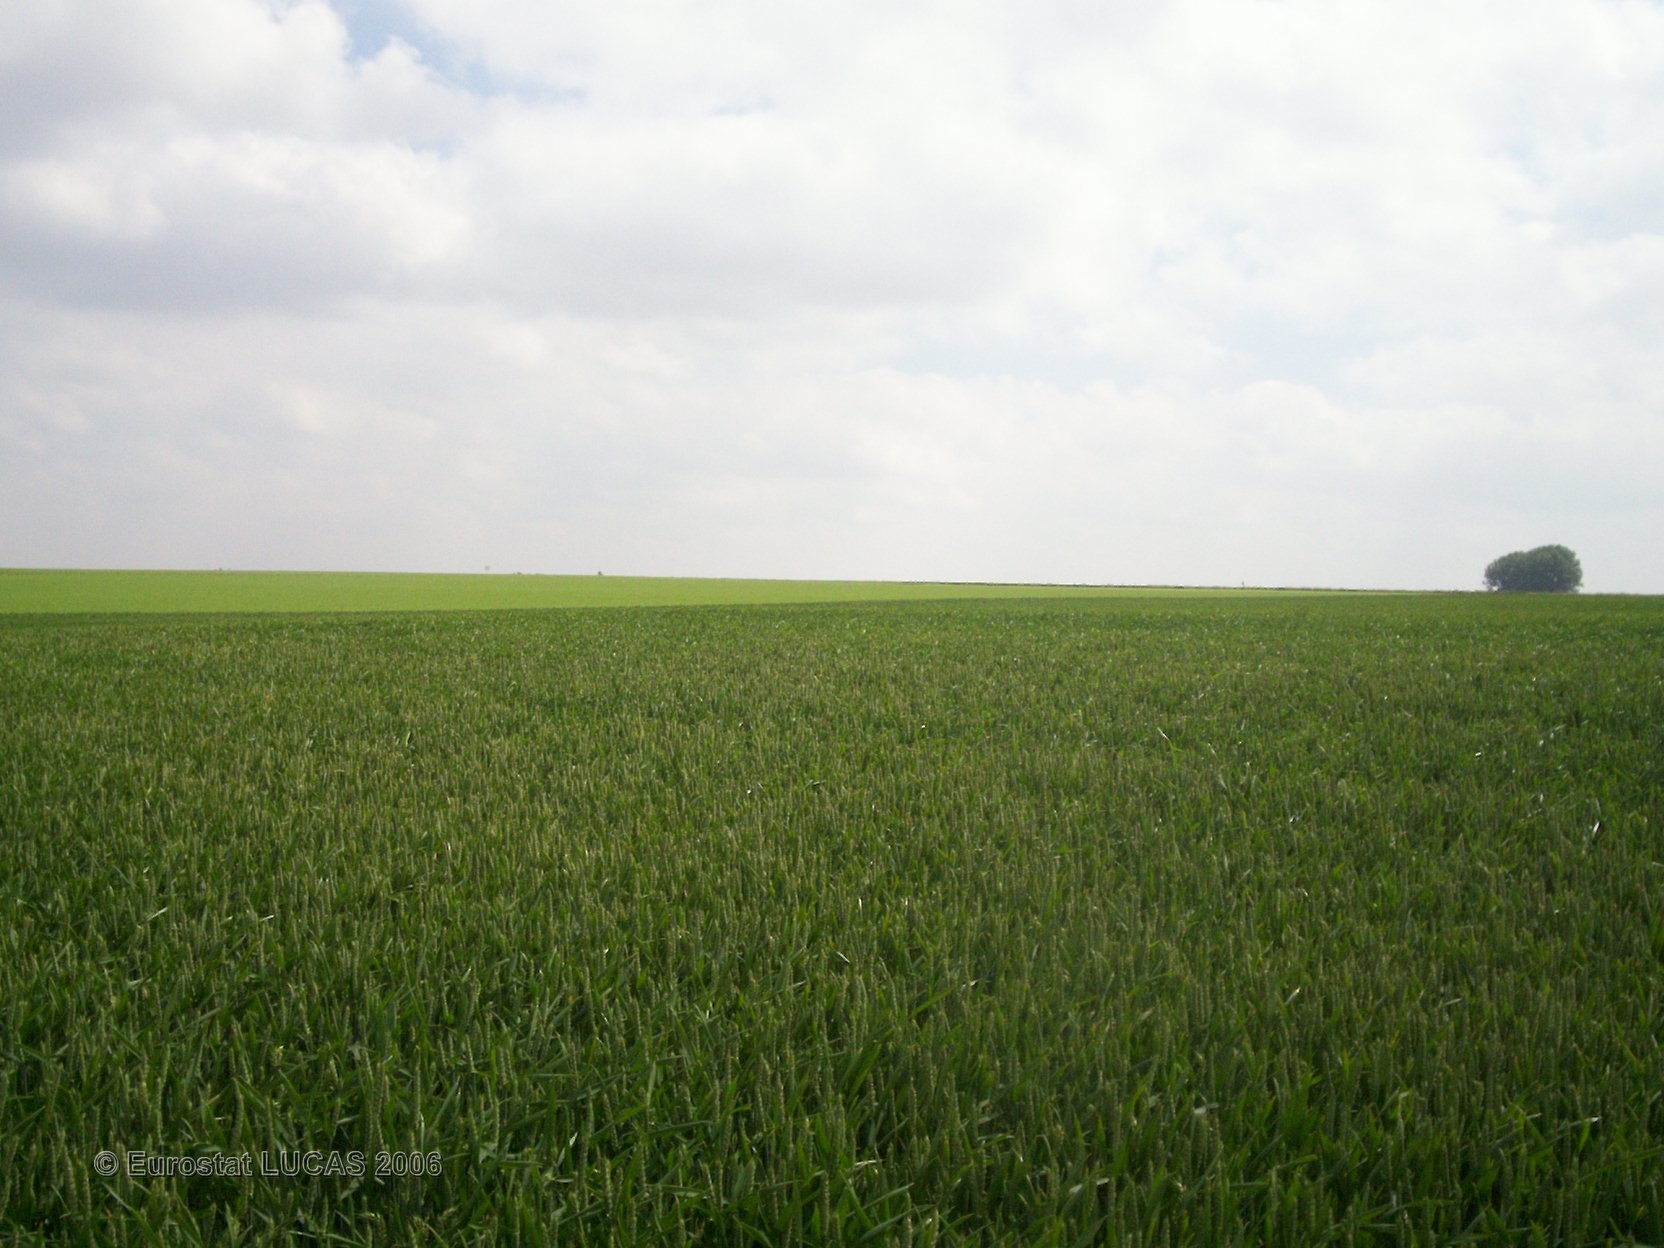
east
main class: Cropland
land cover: Common wheat
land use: Agriculture (excluding fallow land and kitchen gardens)
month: June
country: FR
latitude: 49.8965
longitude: 2.7080
